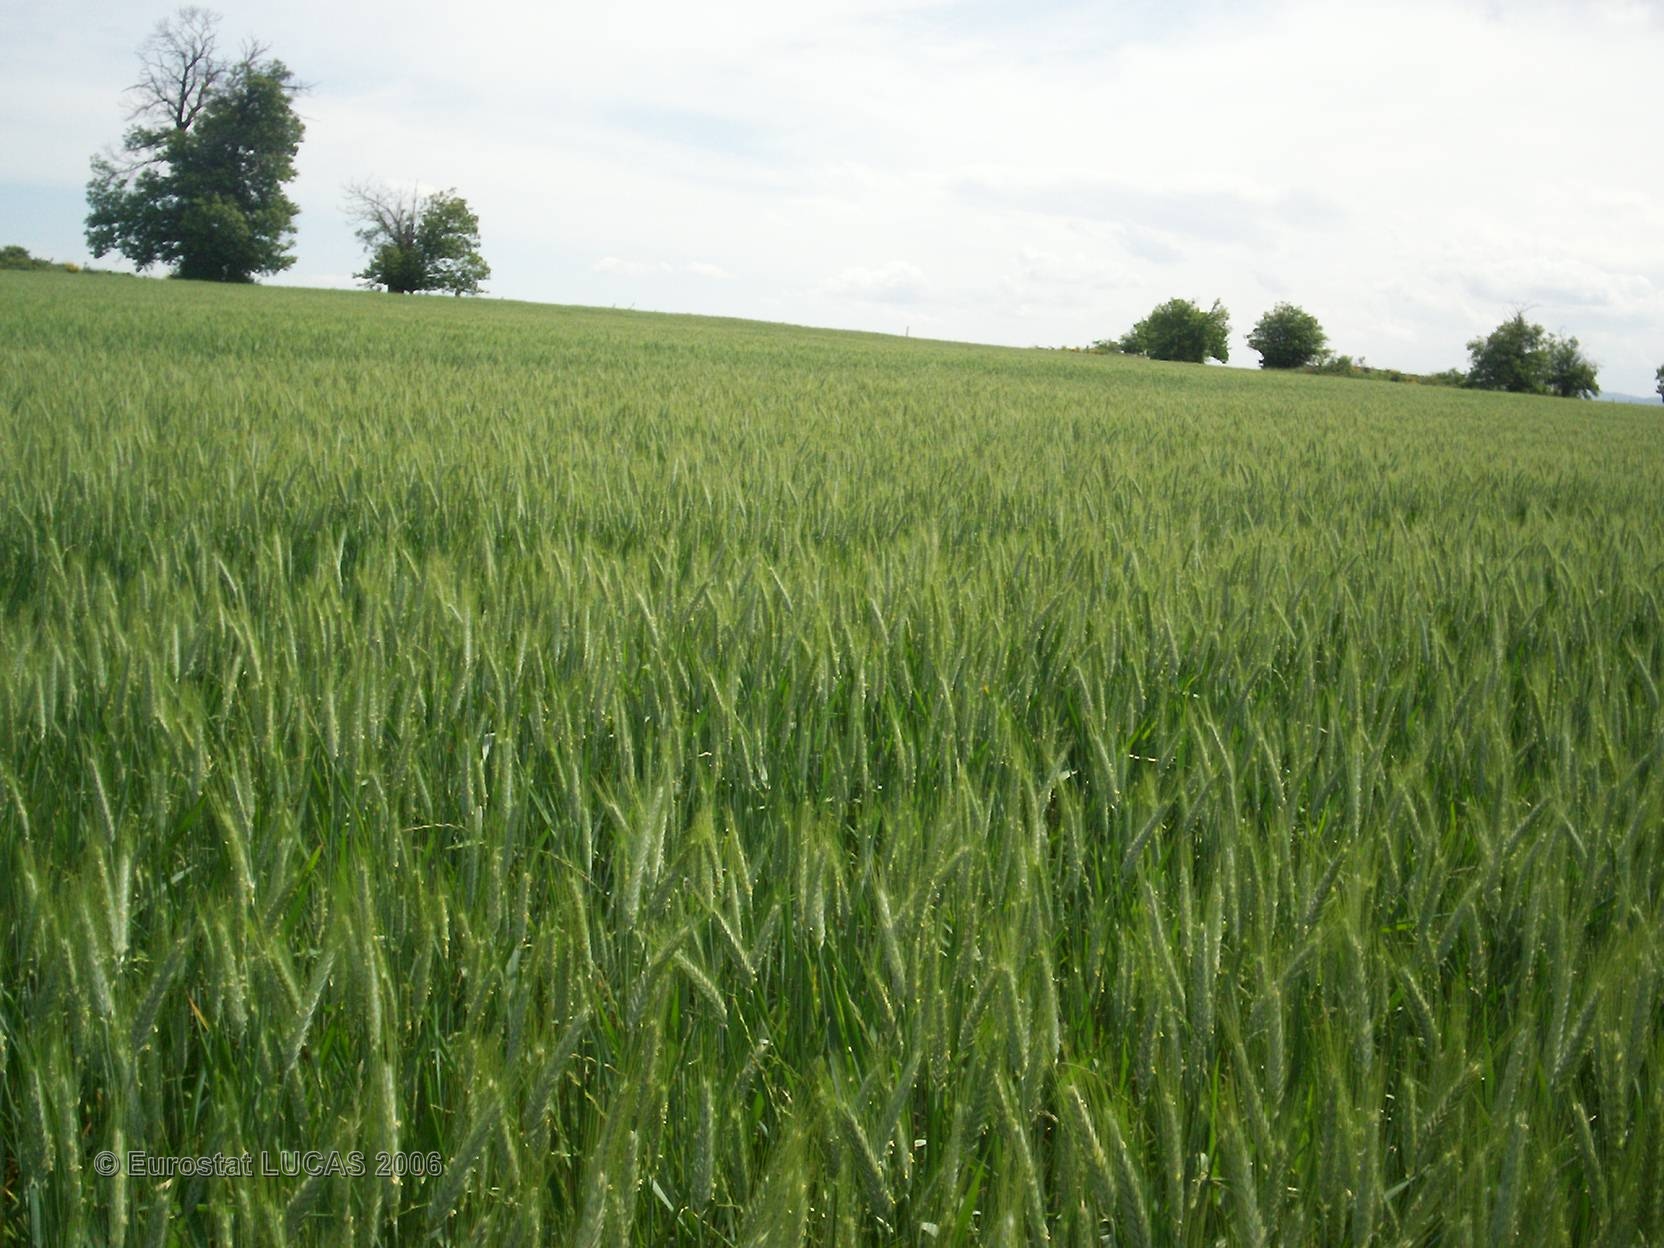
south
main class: Cropland
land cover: Triticale
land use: Agriculture (excluding fallow land and kitchen gardens)
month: May
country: FR
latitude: 45.2303
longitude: 4.7699
